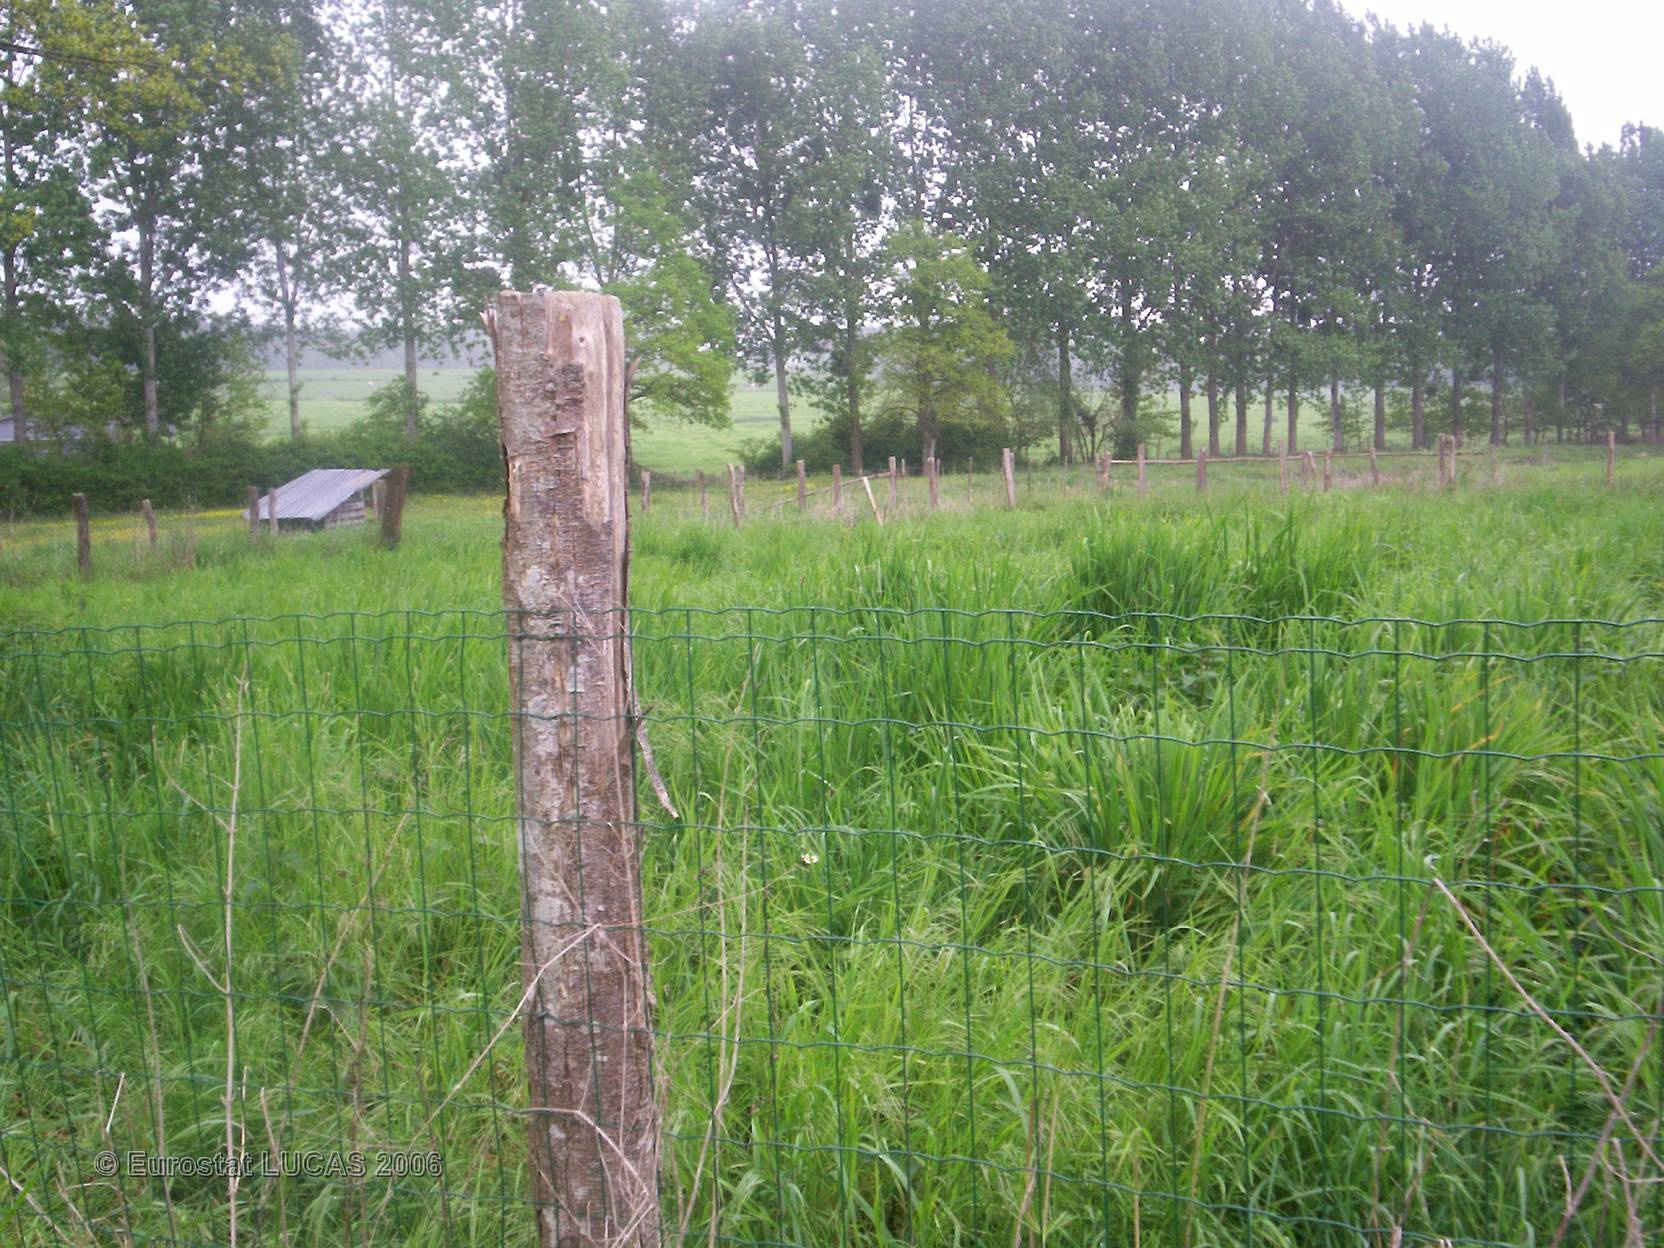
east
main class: Grassland
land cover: Grassland without tree/shrub cover
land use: Agriculture (excluding fallow land and kitchen gardens)
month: May
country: FR
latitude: 47.9132
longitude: 0.4093
